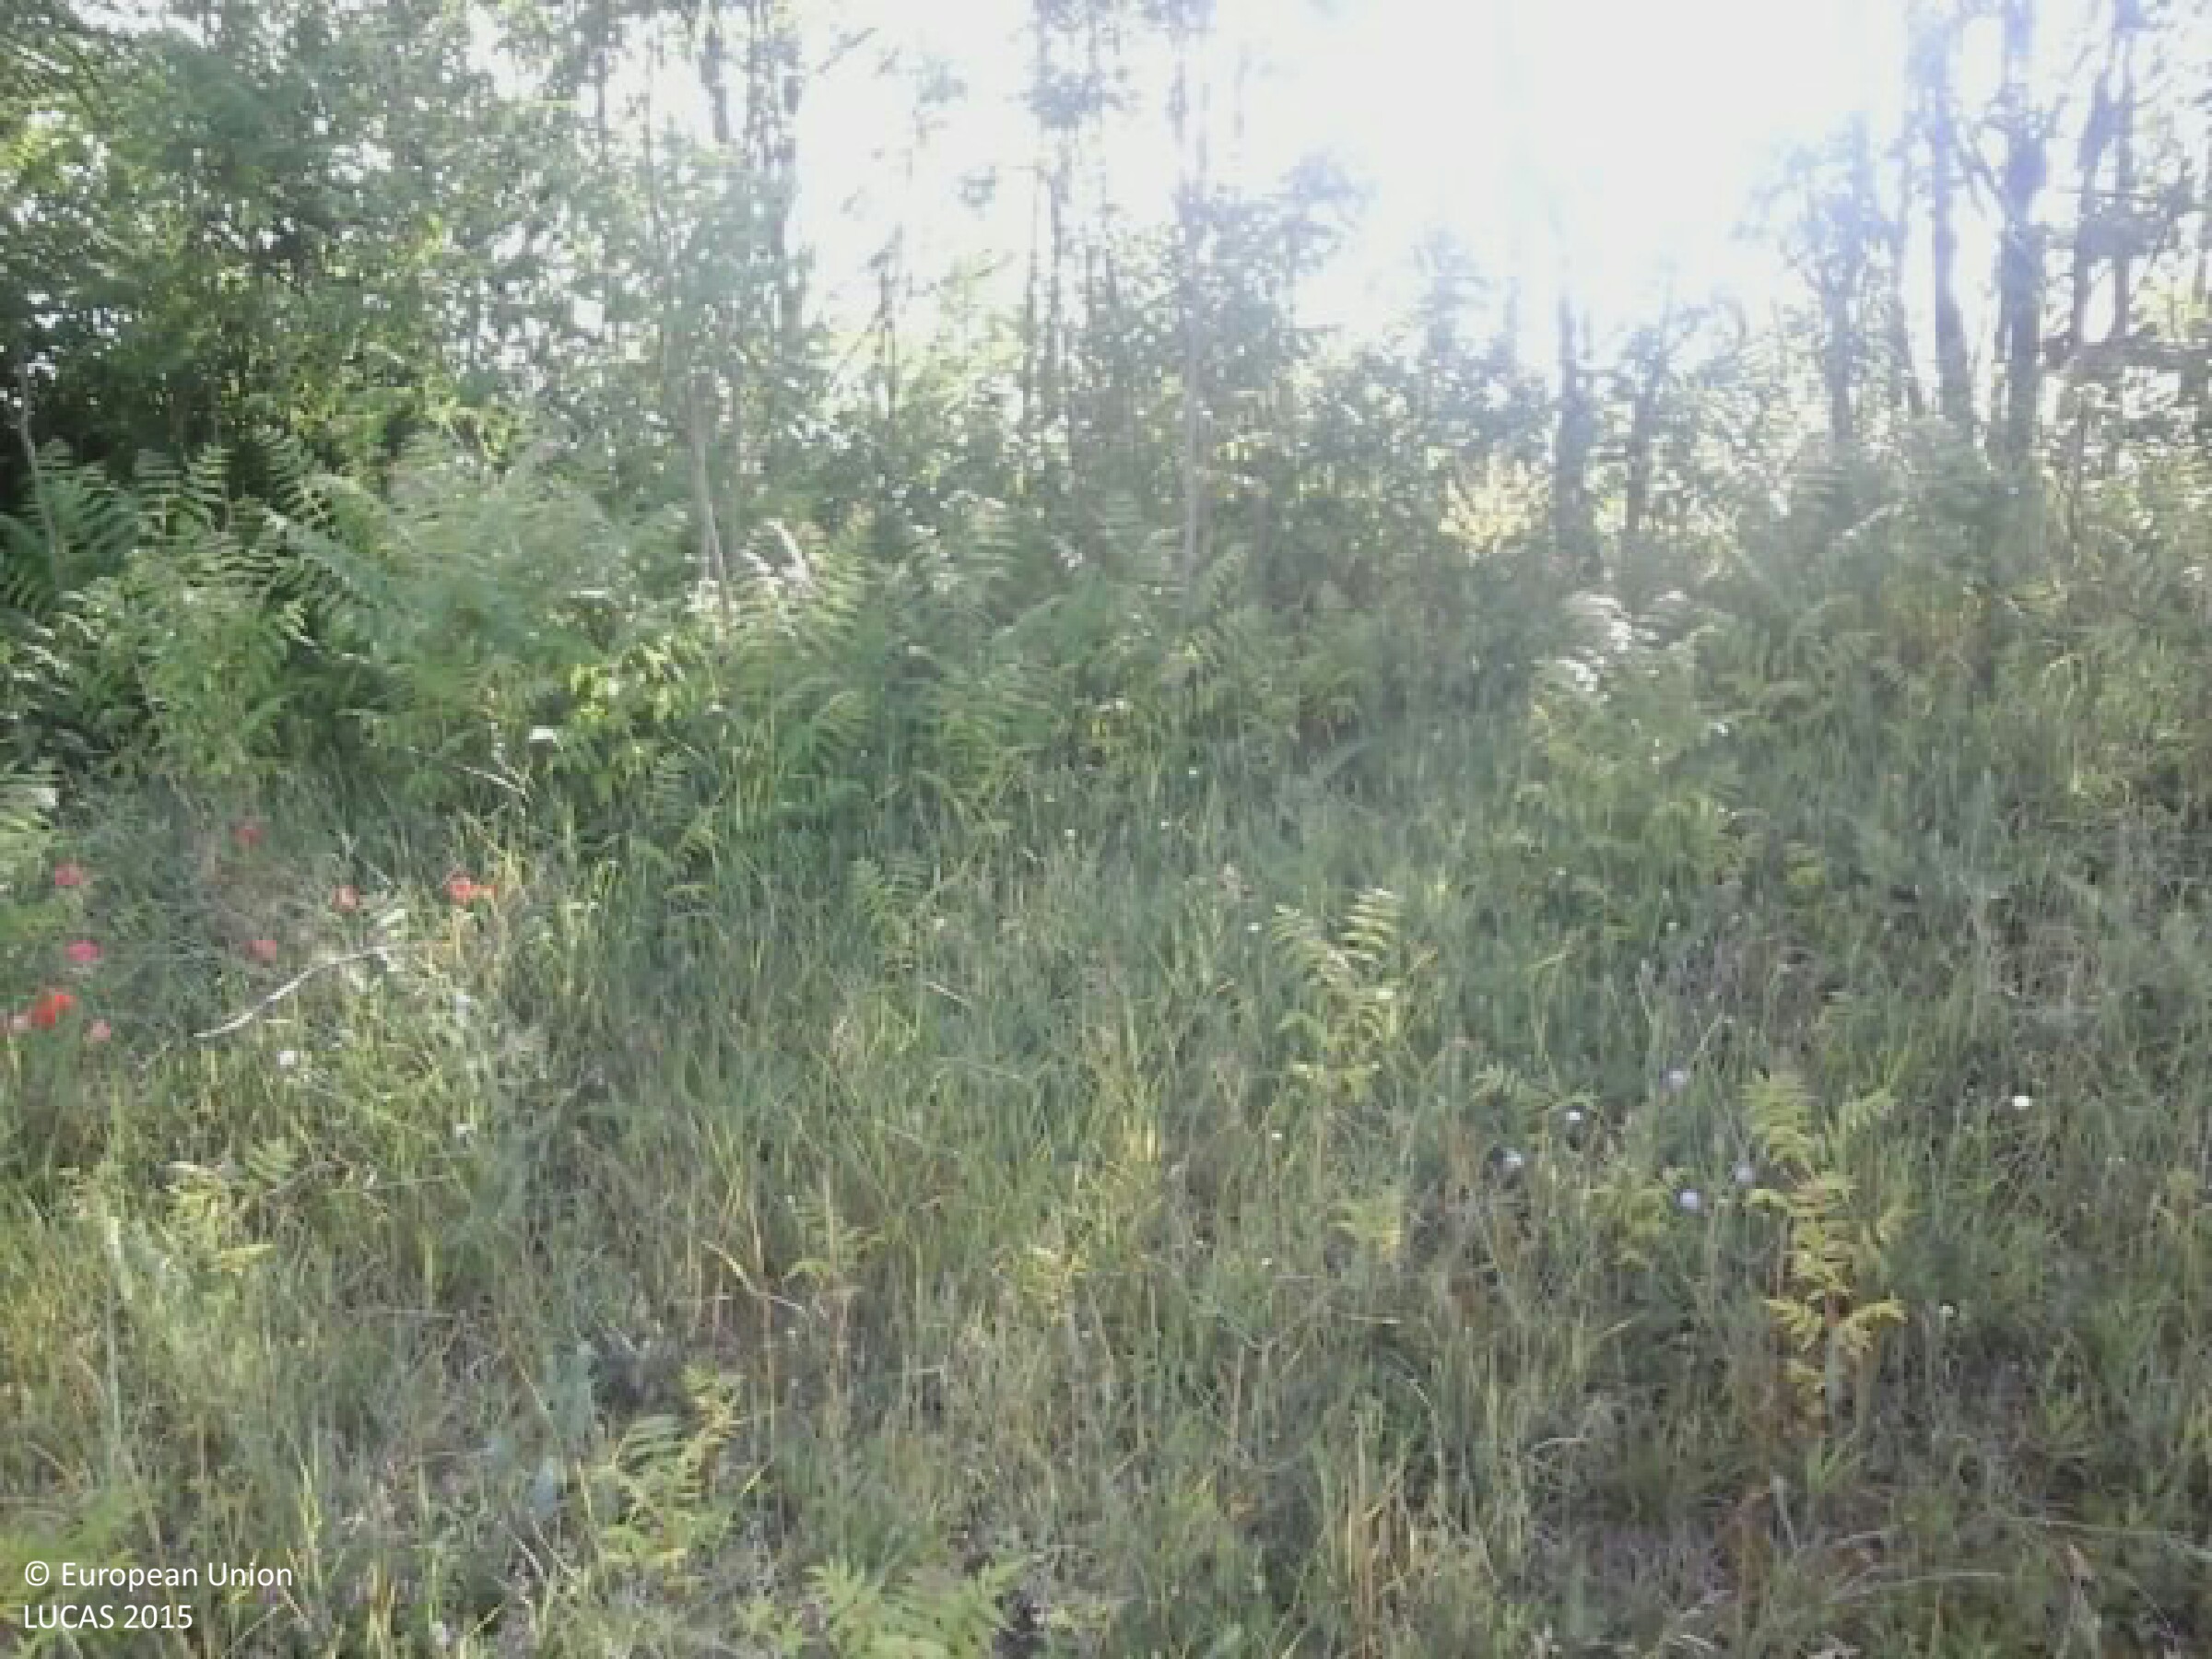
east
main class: Grassland
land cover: Grassland with sparse tree/shrub cover
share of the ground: > 75 %
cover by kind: herbaceous plants 85 %, shrubs 10 %, broadleaved forest trees 5 %
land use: Semi-natural and natural areas not in use
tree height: < 5 m
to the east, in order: Grassland with sparse tree/shrub cover; Broadleaved woodland; Grassland without tree/shrub cover; Grassland with sparse tree/shrub cover; Grass margins; Tracks; Grass margins; Artificial constructions in urban areas; Lines of trees; Grassland without tree/shrub cover; Tracks
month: June
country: HU
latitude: 46.1893
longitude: 18.9913
